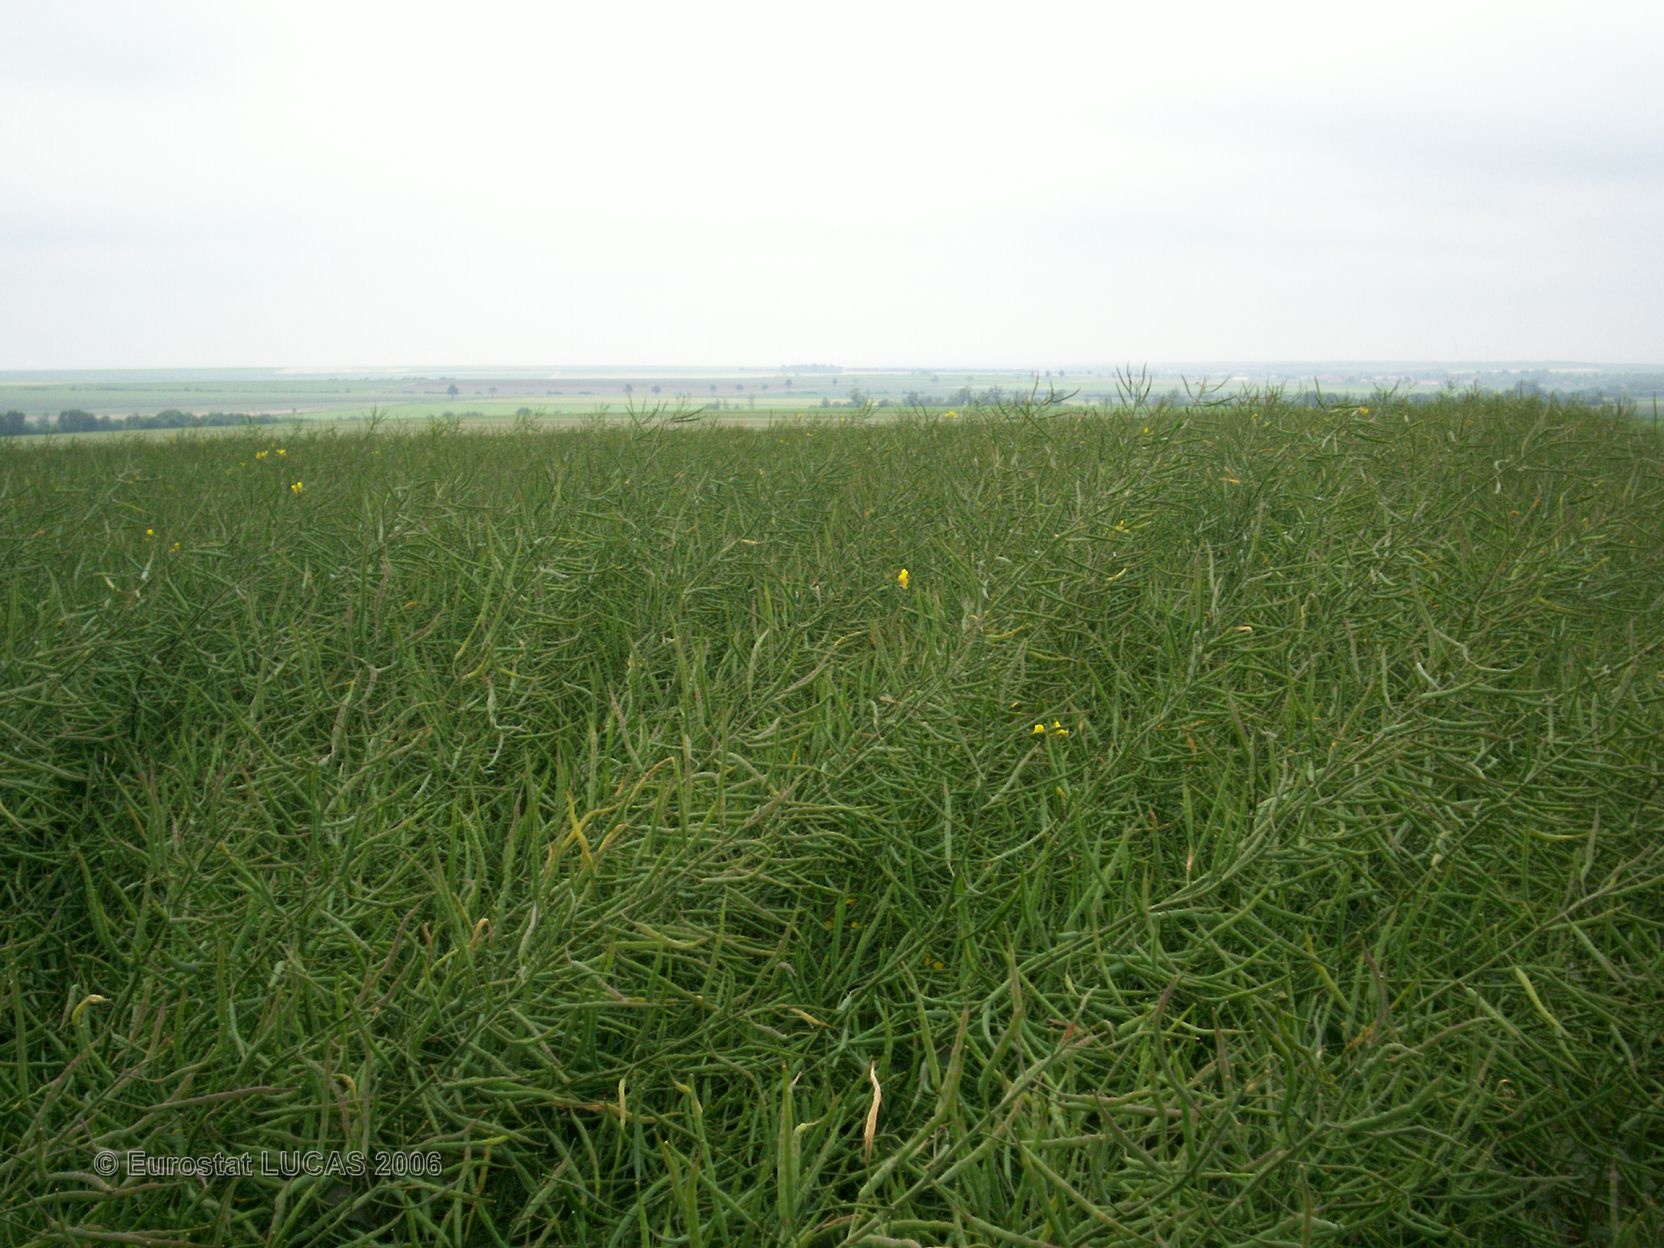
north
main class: Cropland
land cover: Rape and turnip rape
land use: Agriculture (excluding fallow land and kitchen gardens)
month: June
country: FR
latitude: 48.7489
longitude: 4.4069
